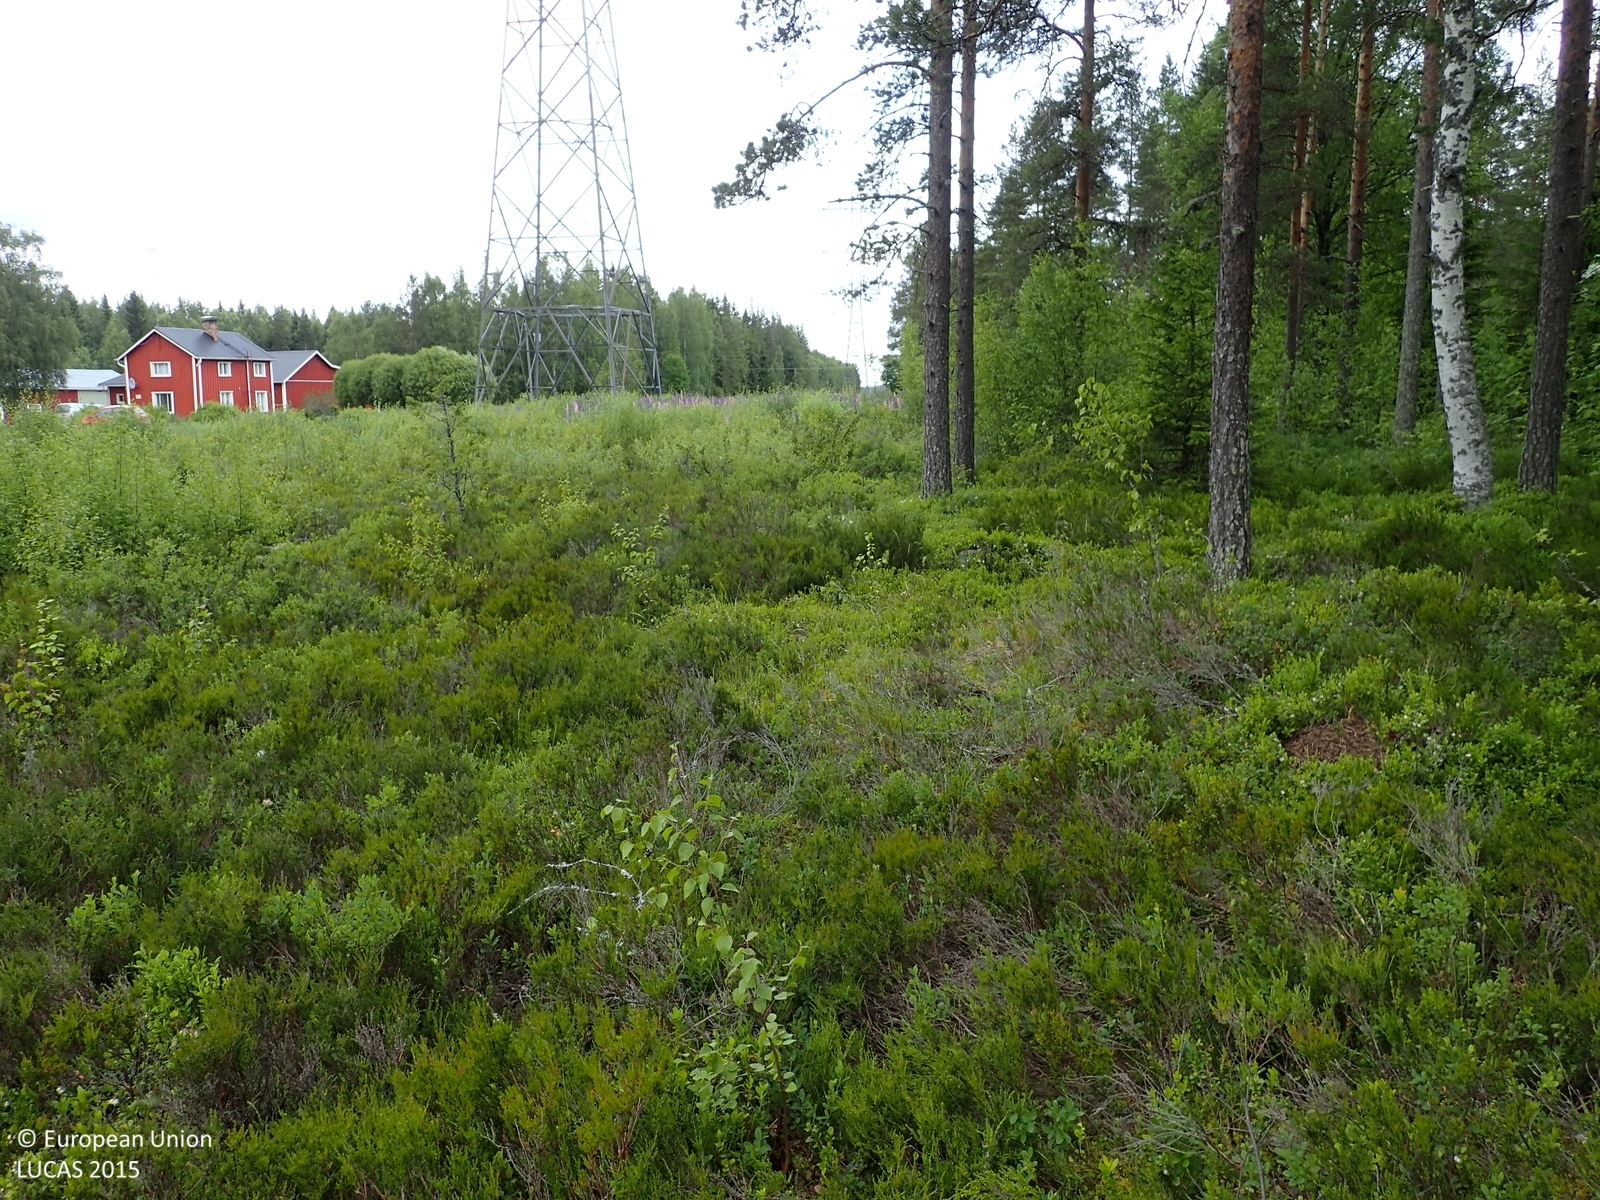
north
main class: Shrubland
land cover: Shrubland with sparse tree cover
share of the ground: > 75 %
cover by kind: shrubs 80 %, herbaceous plants 10 %, broadleaved forest trees 5 %, lichens and mosses 5 %
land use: Electricity, gas and thermal power distribution
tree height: < 5 m
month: July
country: FI
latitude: 62.7371
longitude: 21.7262
